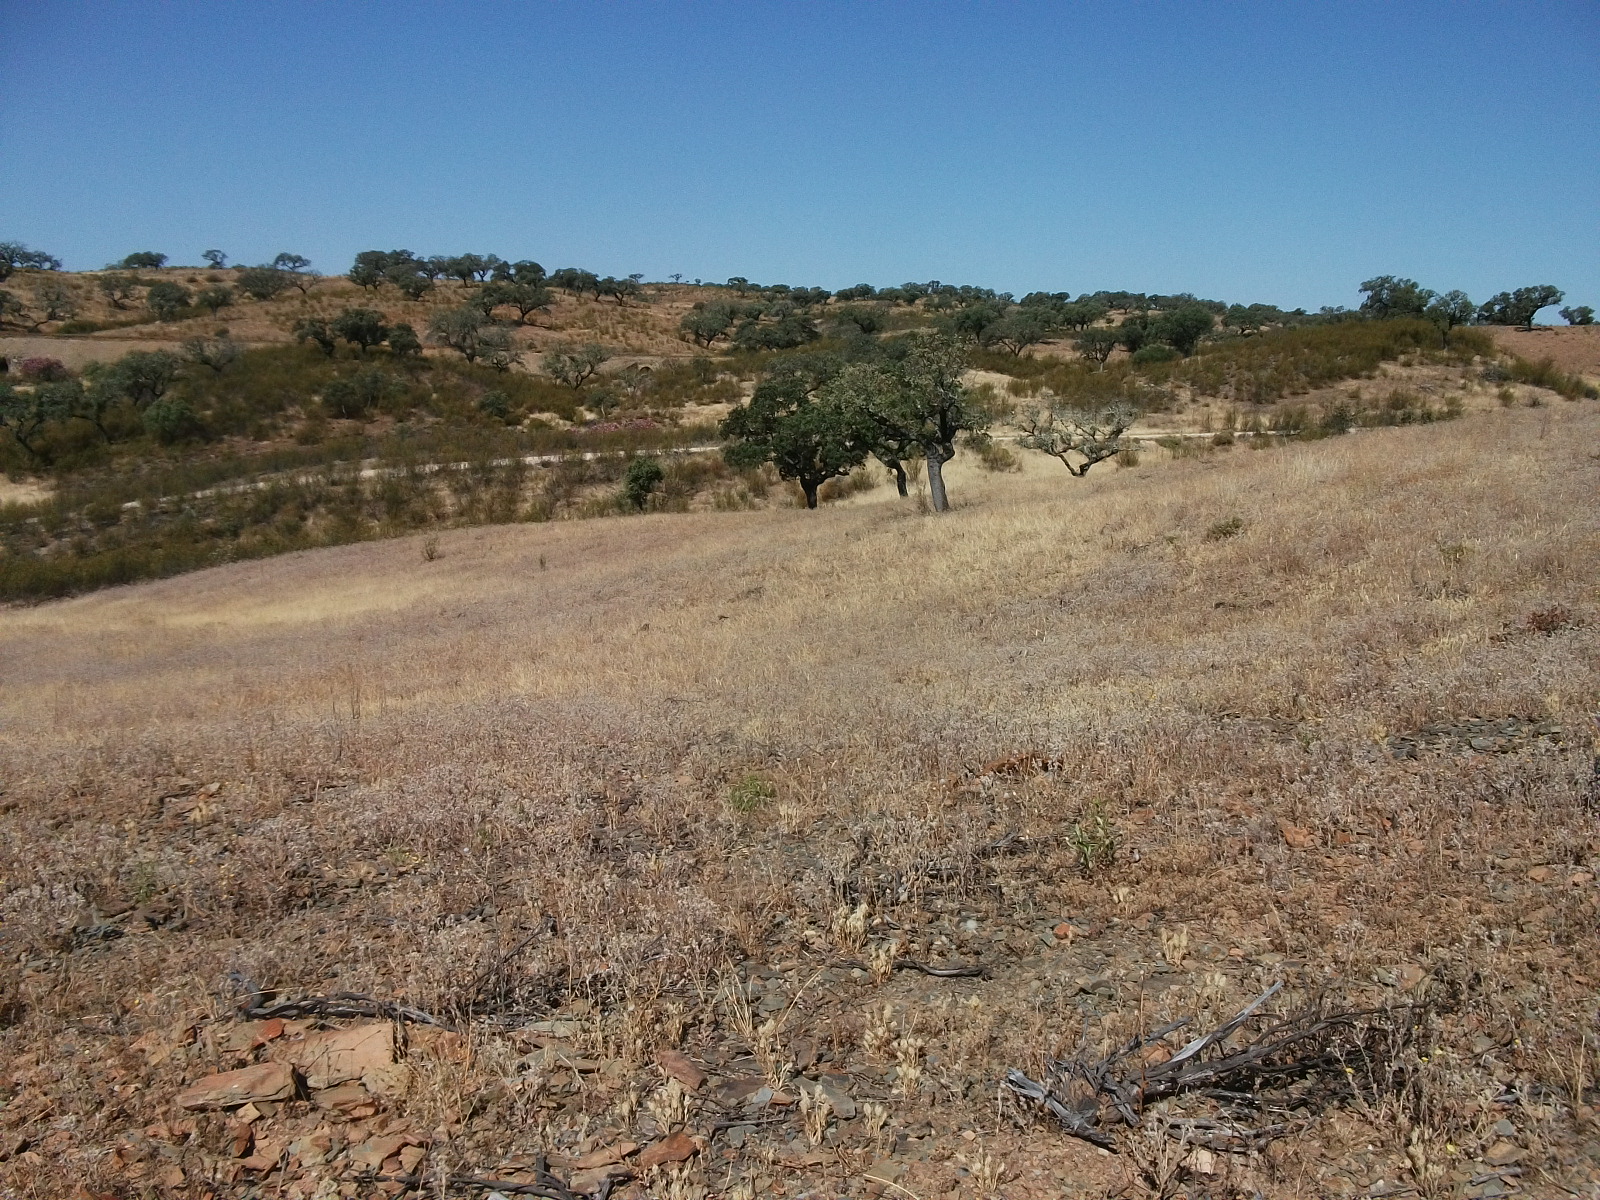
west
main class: Woodland
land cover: Broadleaved woodland
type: broadleaved evergreen forest
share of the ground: 25 - 50 %
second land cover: Grassland without tree/shrub cover
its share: > 75 %
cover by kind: herbaceous plants 70 %, broadleaved forest trees 30 %
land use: Forestry
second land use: Agriculture (excluding fallow land and kitchen gardens)
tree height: > 5 m
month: June
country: ES
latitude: 37.6039
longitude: -7.0263
